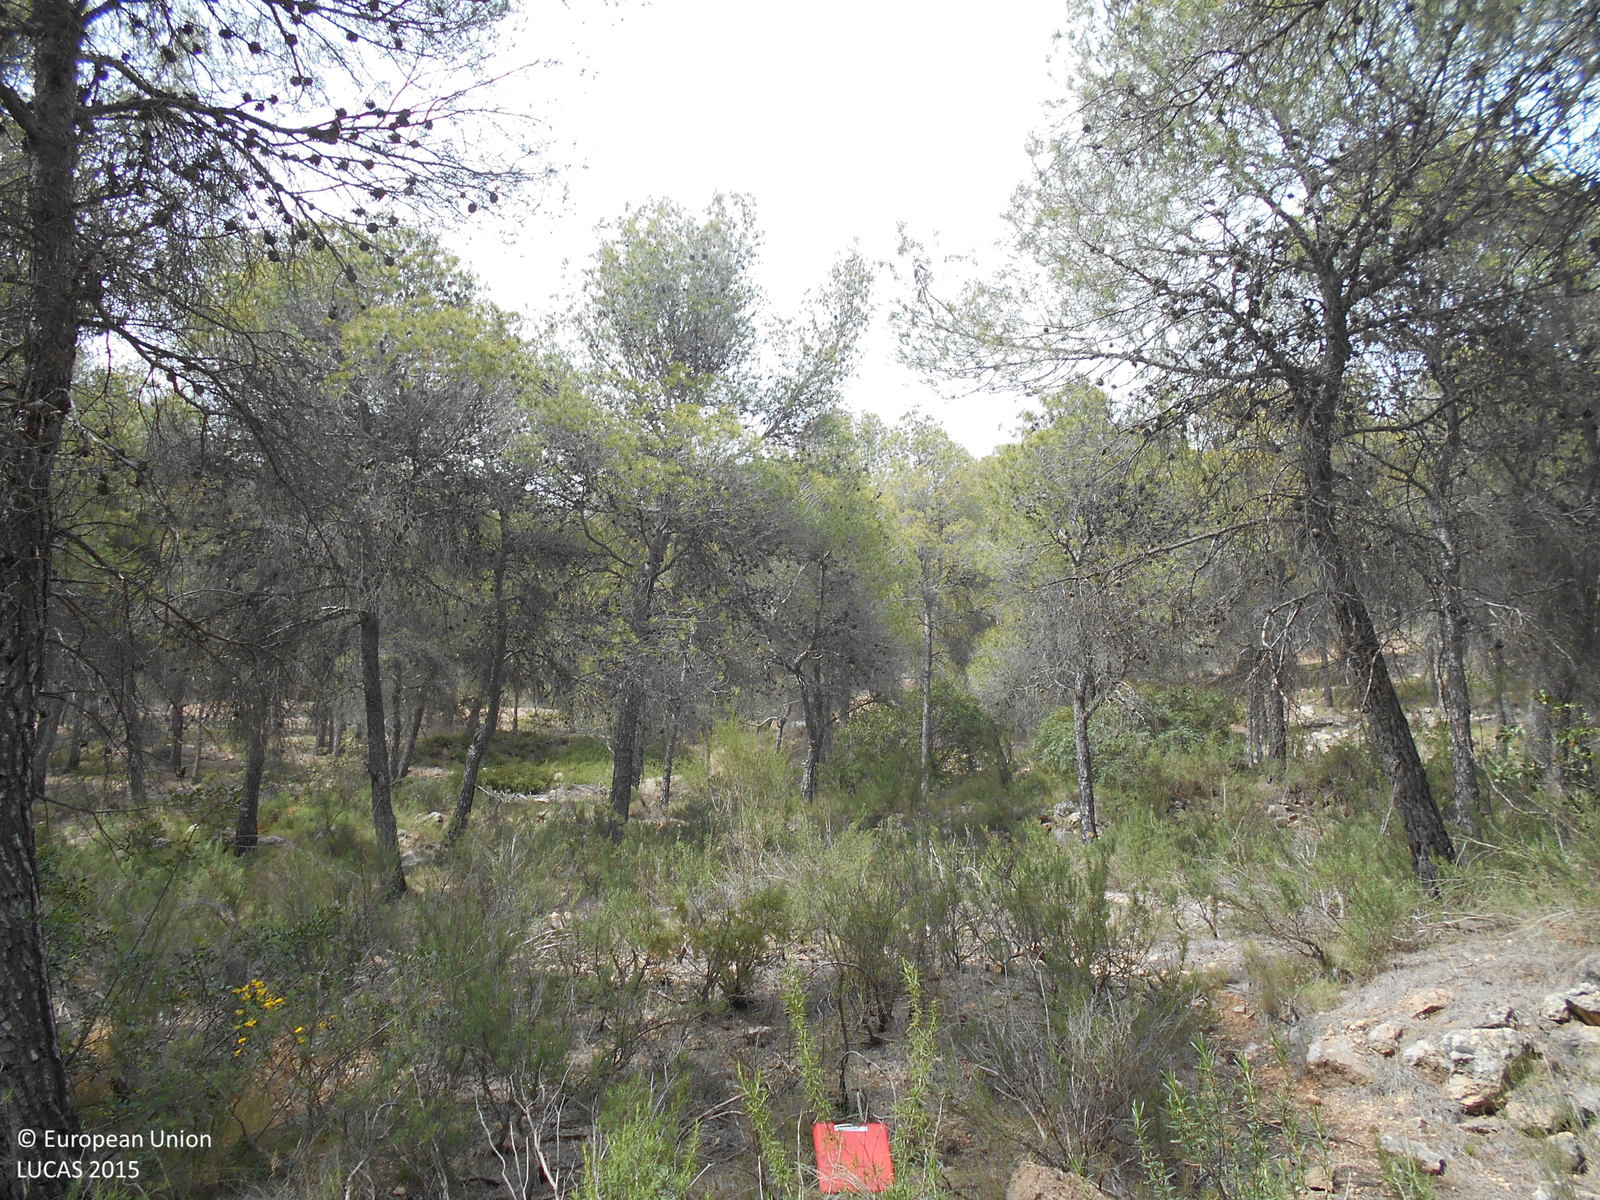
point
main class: Woodland
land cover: Pine dominated coniferous woodland
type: coniferous forest of the mediterranean region
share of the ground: > 75 %
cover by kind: coniferous forest trees 75 %, shrubs 20 %, unconsolidated bare surface 5 %
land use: Semi-natural and natural areas not in use
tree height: > 5 m
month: April
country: ES
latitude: 37.8708
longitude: -1.5000
